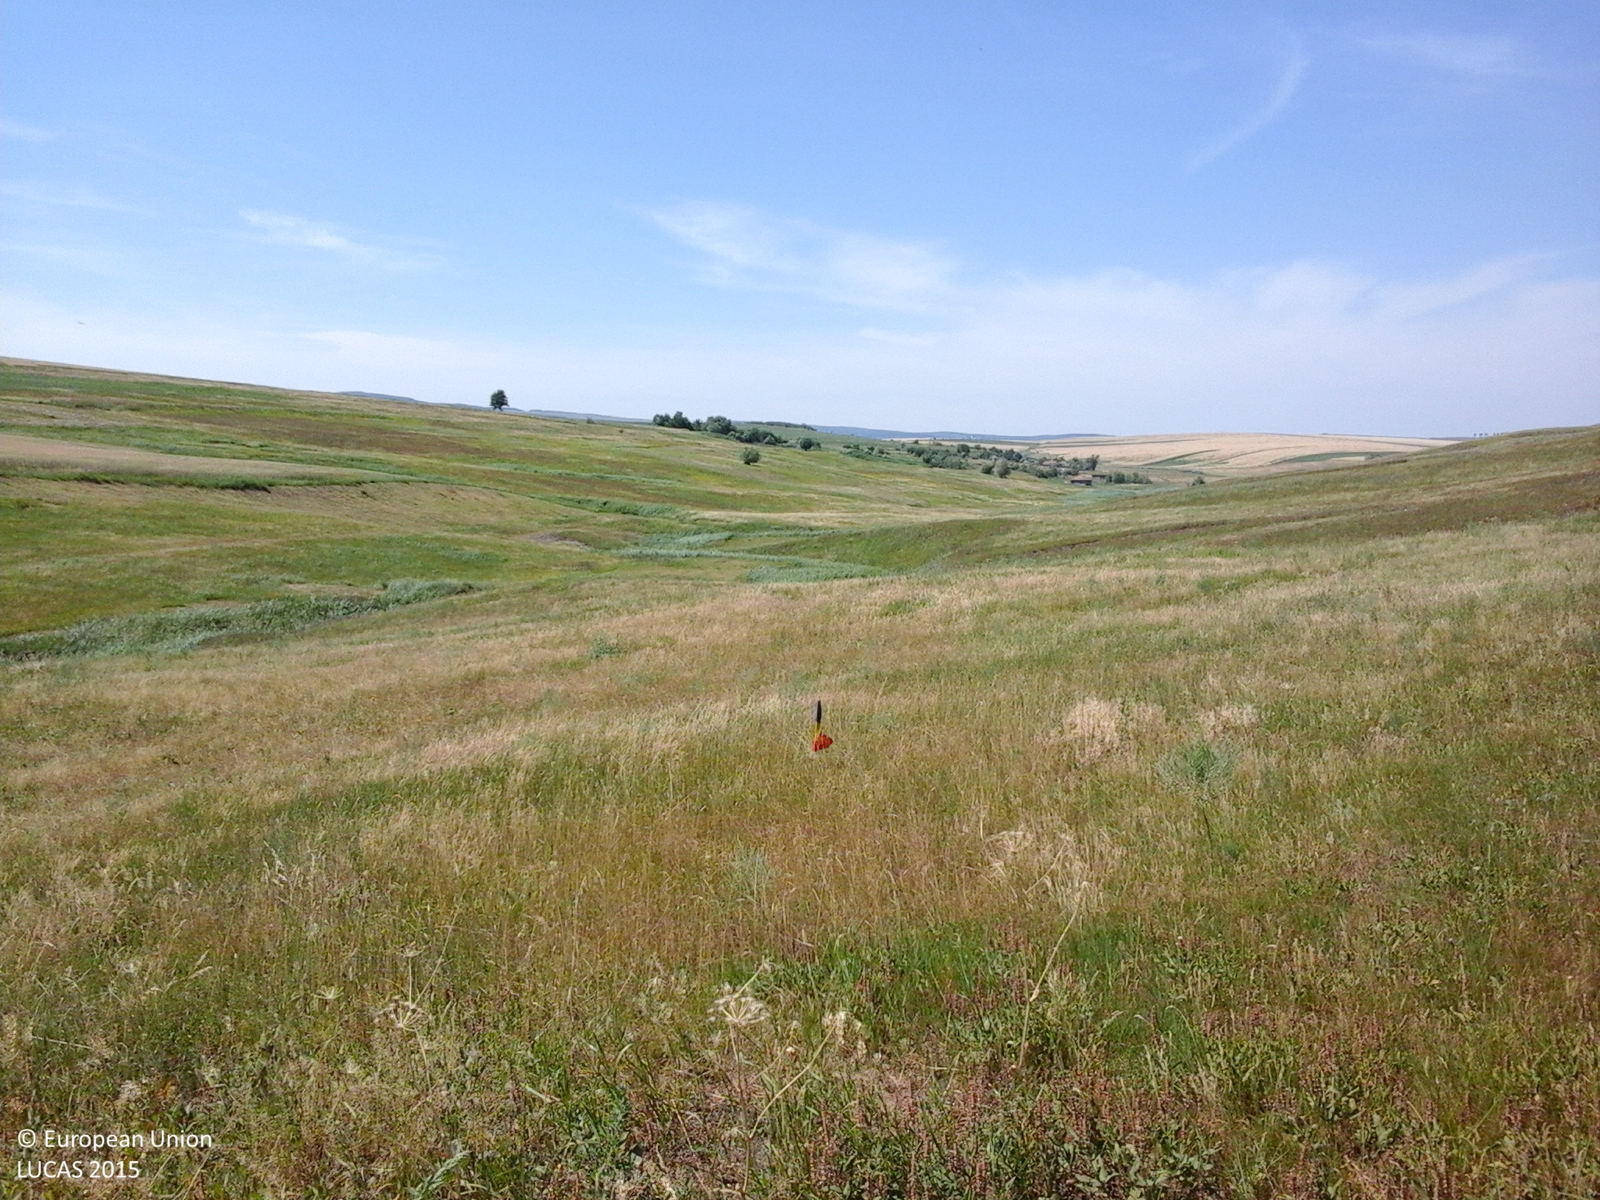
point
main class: Grassland
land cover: Grassland without tree/shrub cover
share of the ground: > 75 %
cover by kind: herbaceous plants 100 %
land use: Agriculture (excluding fallow land and kitchen gardens)
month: June
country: RO
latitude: 47.4833
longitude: 26.9696
